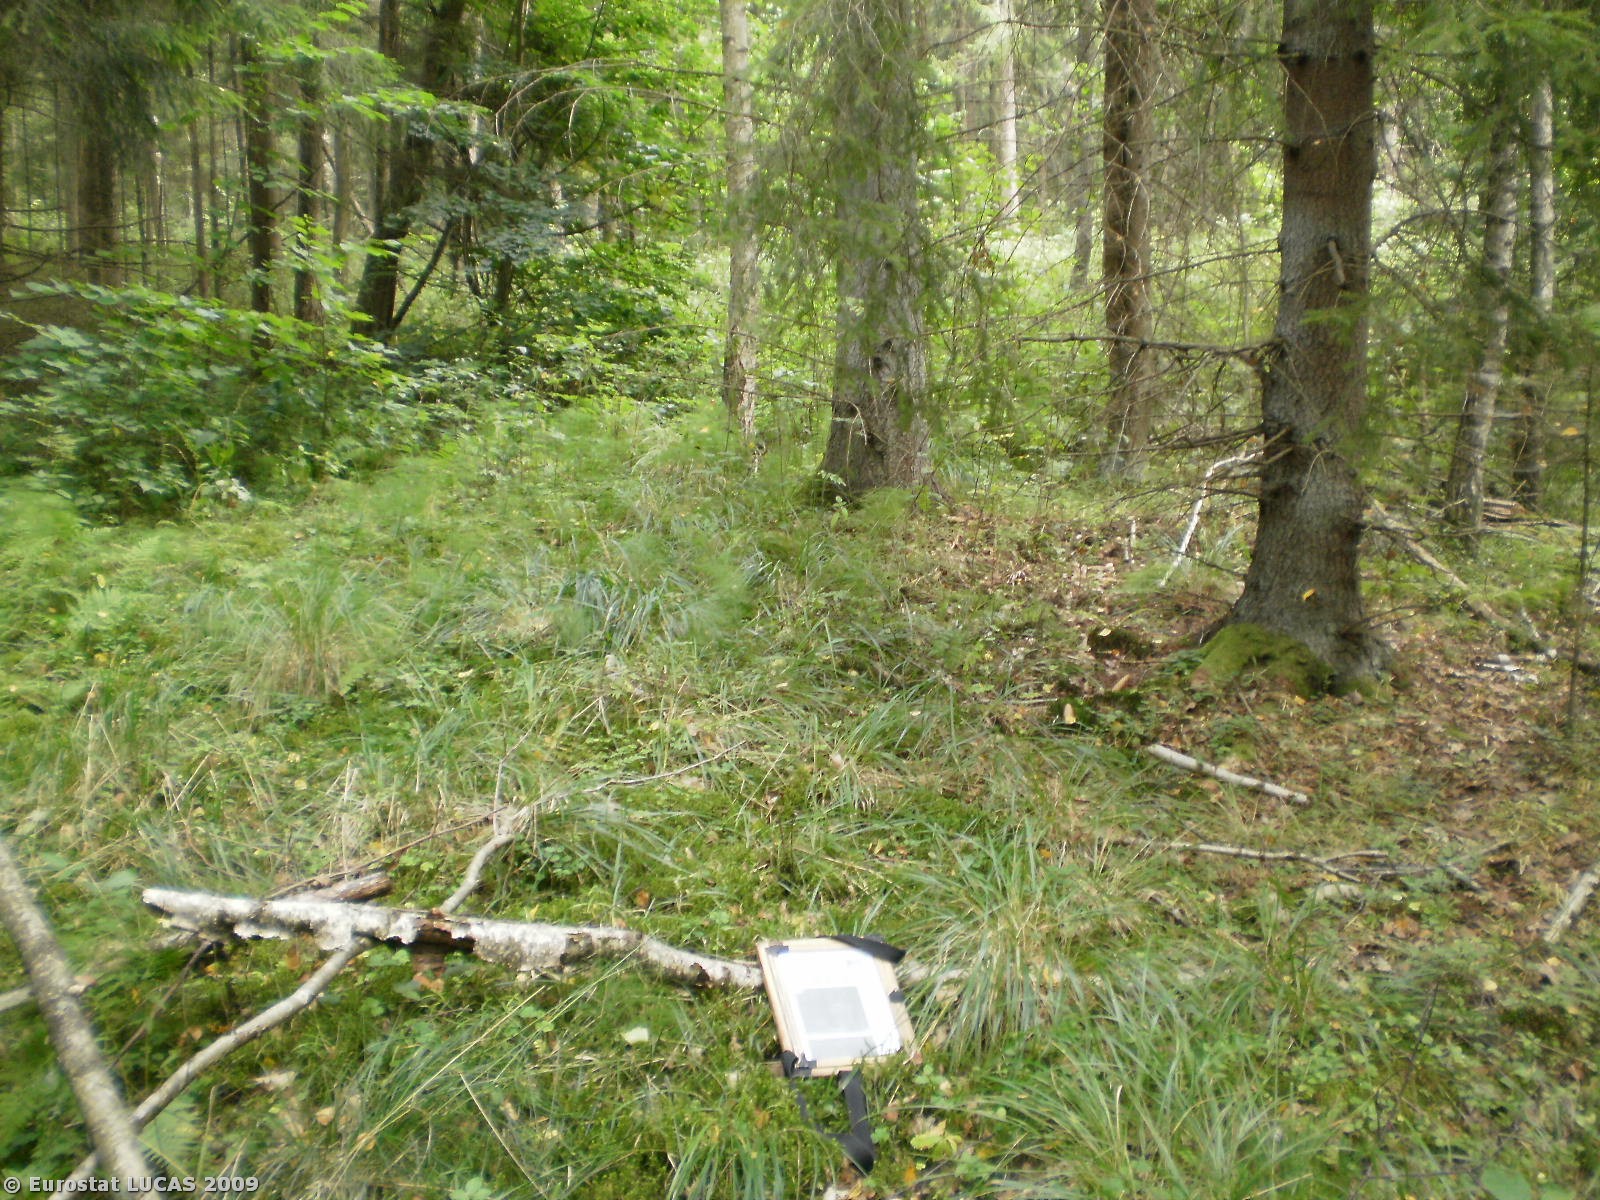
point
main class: Woodland
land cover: Mixed woodland
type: hemiboreal forest and nemoral coniferous forest and mixed broadleaved-coniferous forest
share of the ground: > 75 %
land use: Forestry
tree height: > 5 m
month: August
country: PL
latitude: 54.1322
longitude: 22.1647
